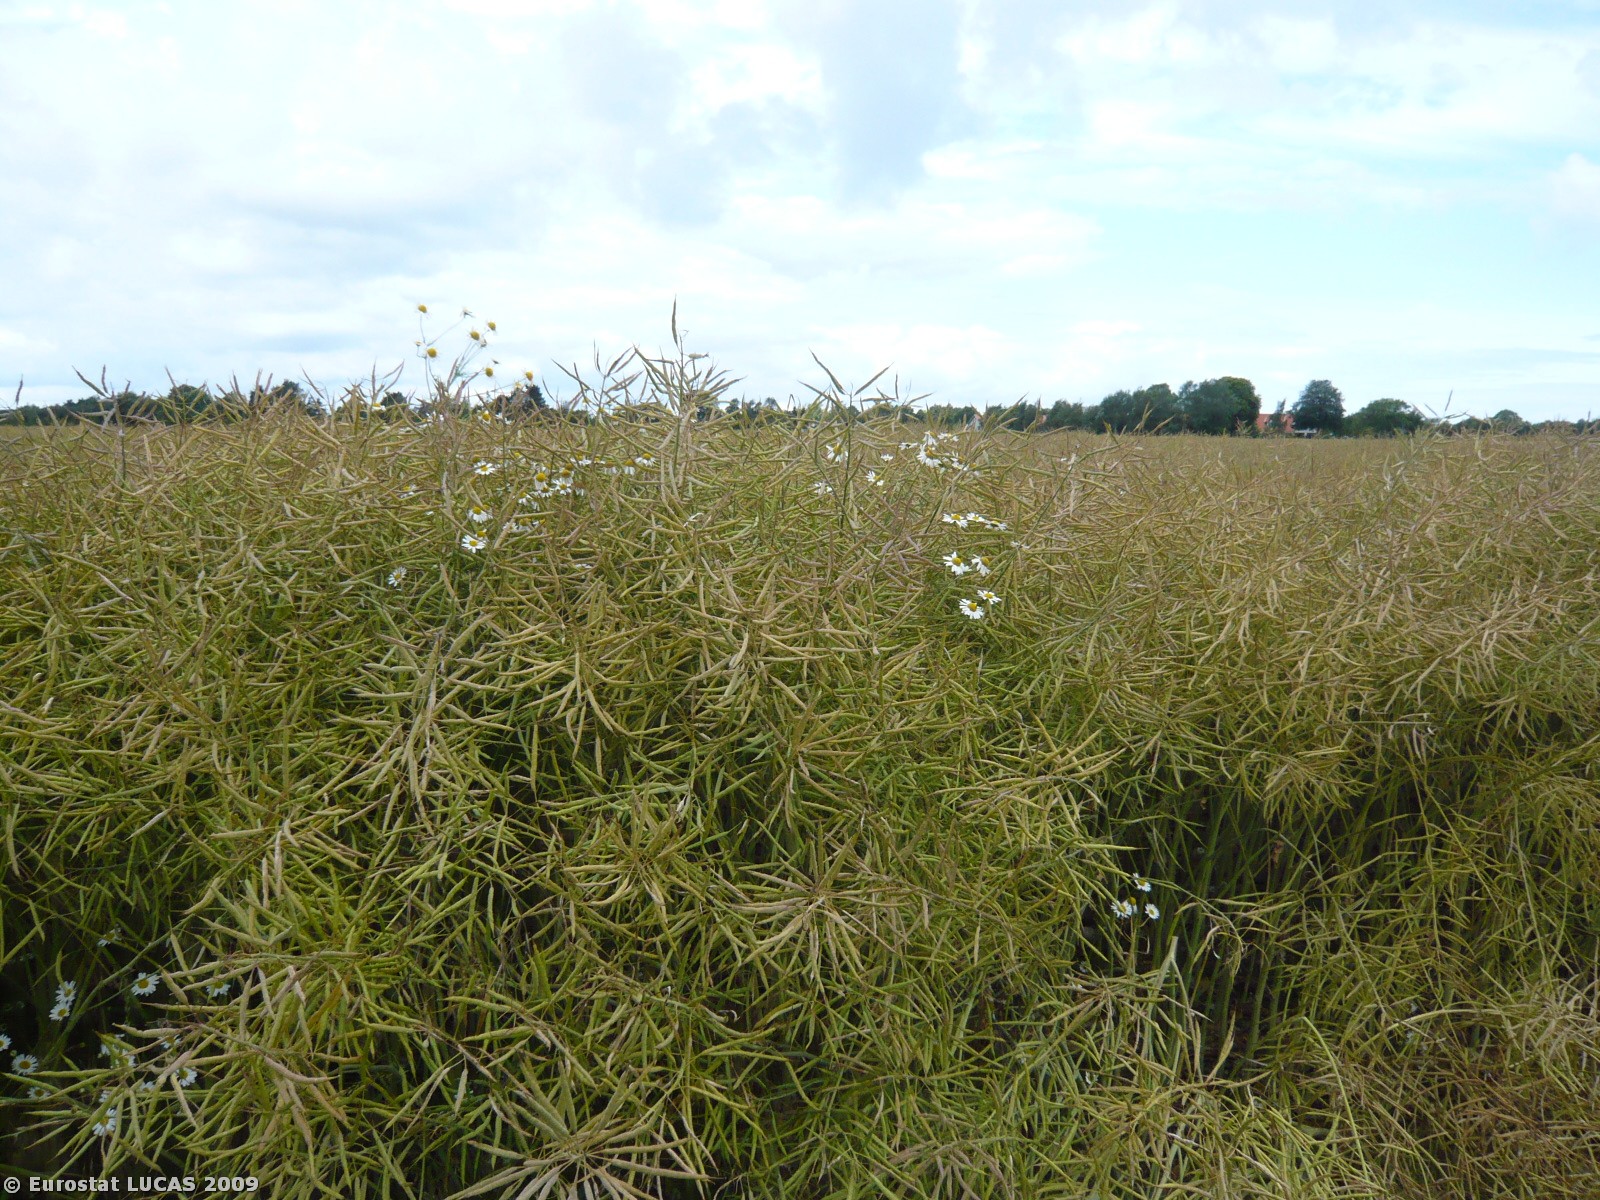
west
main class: Cropland
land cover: Rape and turnip rape
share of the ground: > 75 %
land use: Agriculture (excluding fallow land and kitchen gardens)
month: July
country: DK
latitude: 55.4090
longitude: 11.2151
